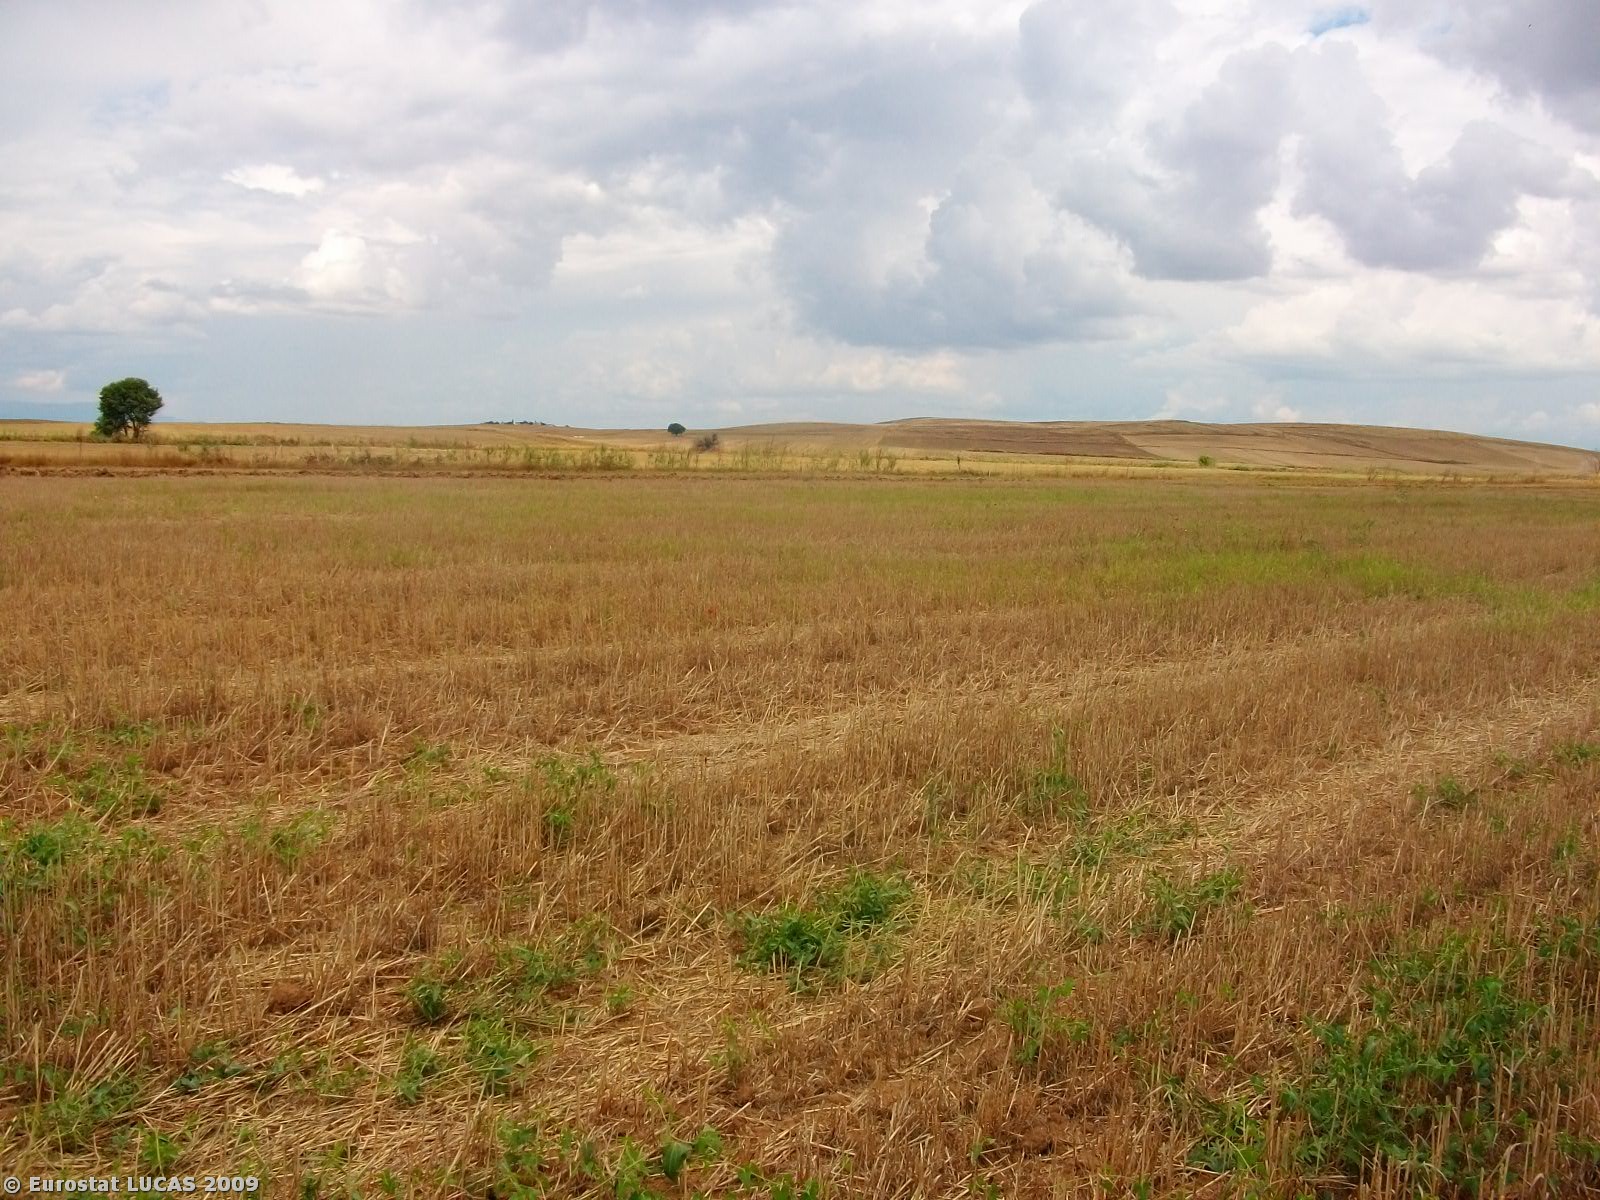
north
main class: Cropland
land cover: Barley
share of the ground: > 75 %
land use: Agriculture (excluding fallow land and kitchen gardens)
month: June
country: GR
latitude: 40.8807
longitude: 22.7170
